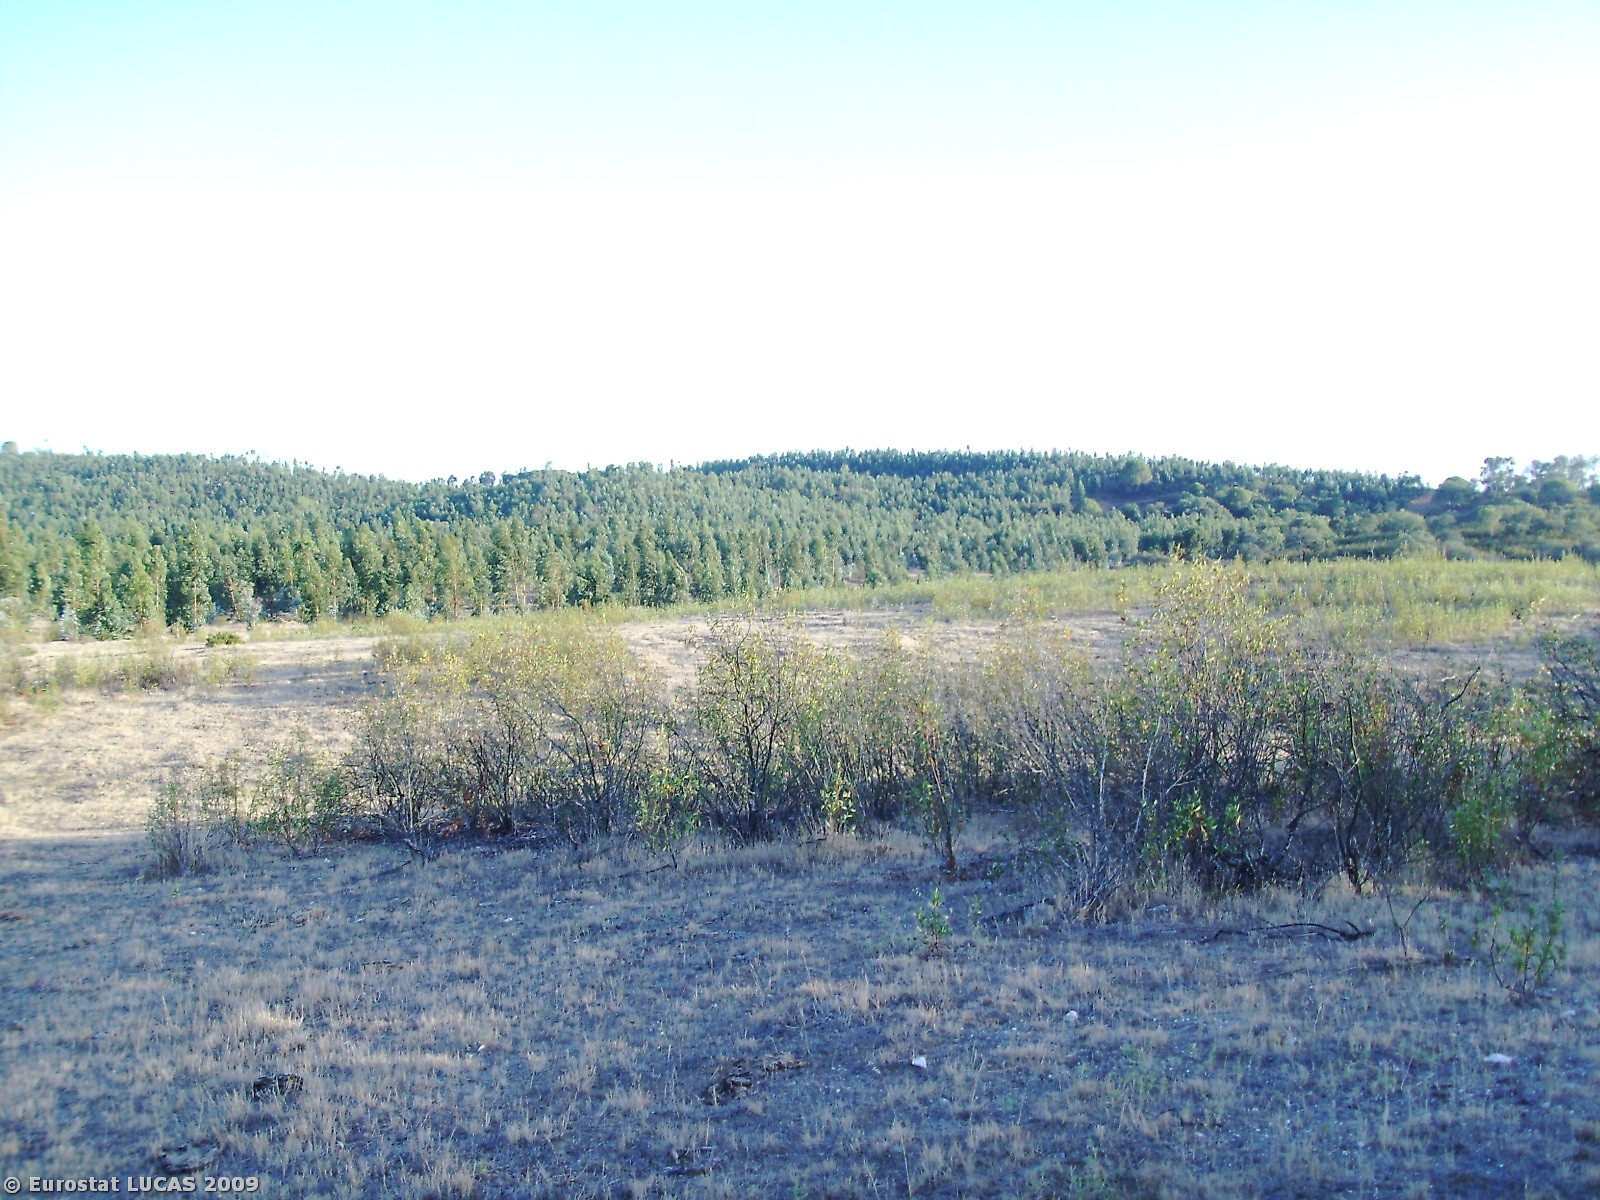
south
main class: Grassland
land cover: Spontaneously vegetated surfaces
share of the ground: 50 - 75 %
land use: Fallow land
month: June
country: PT
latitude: 38.1046
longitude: -8.4854
